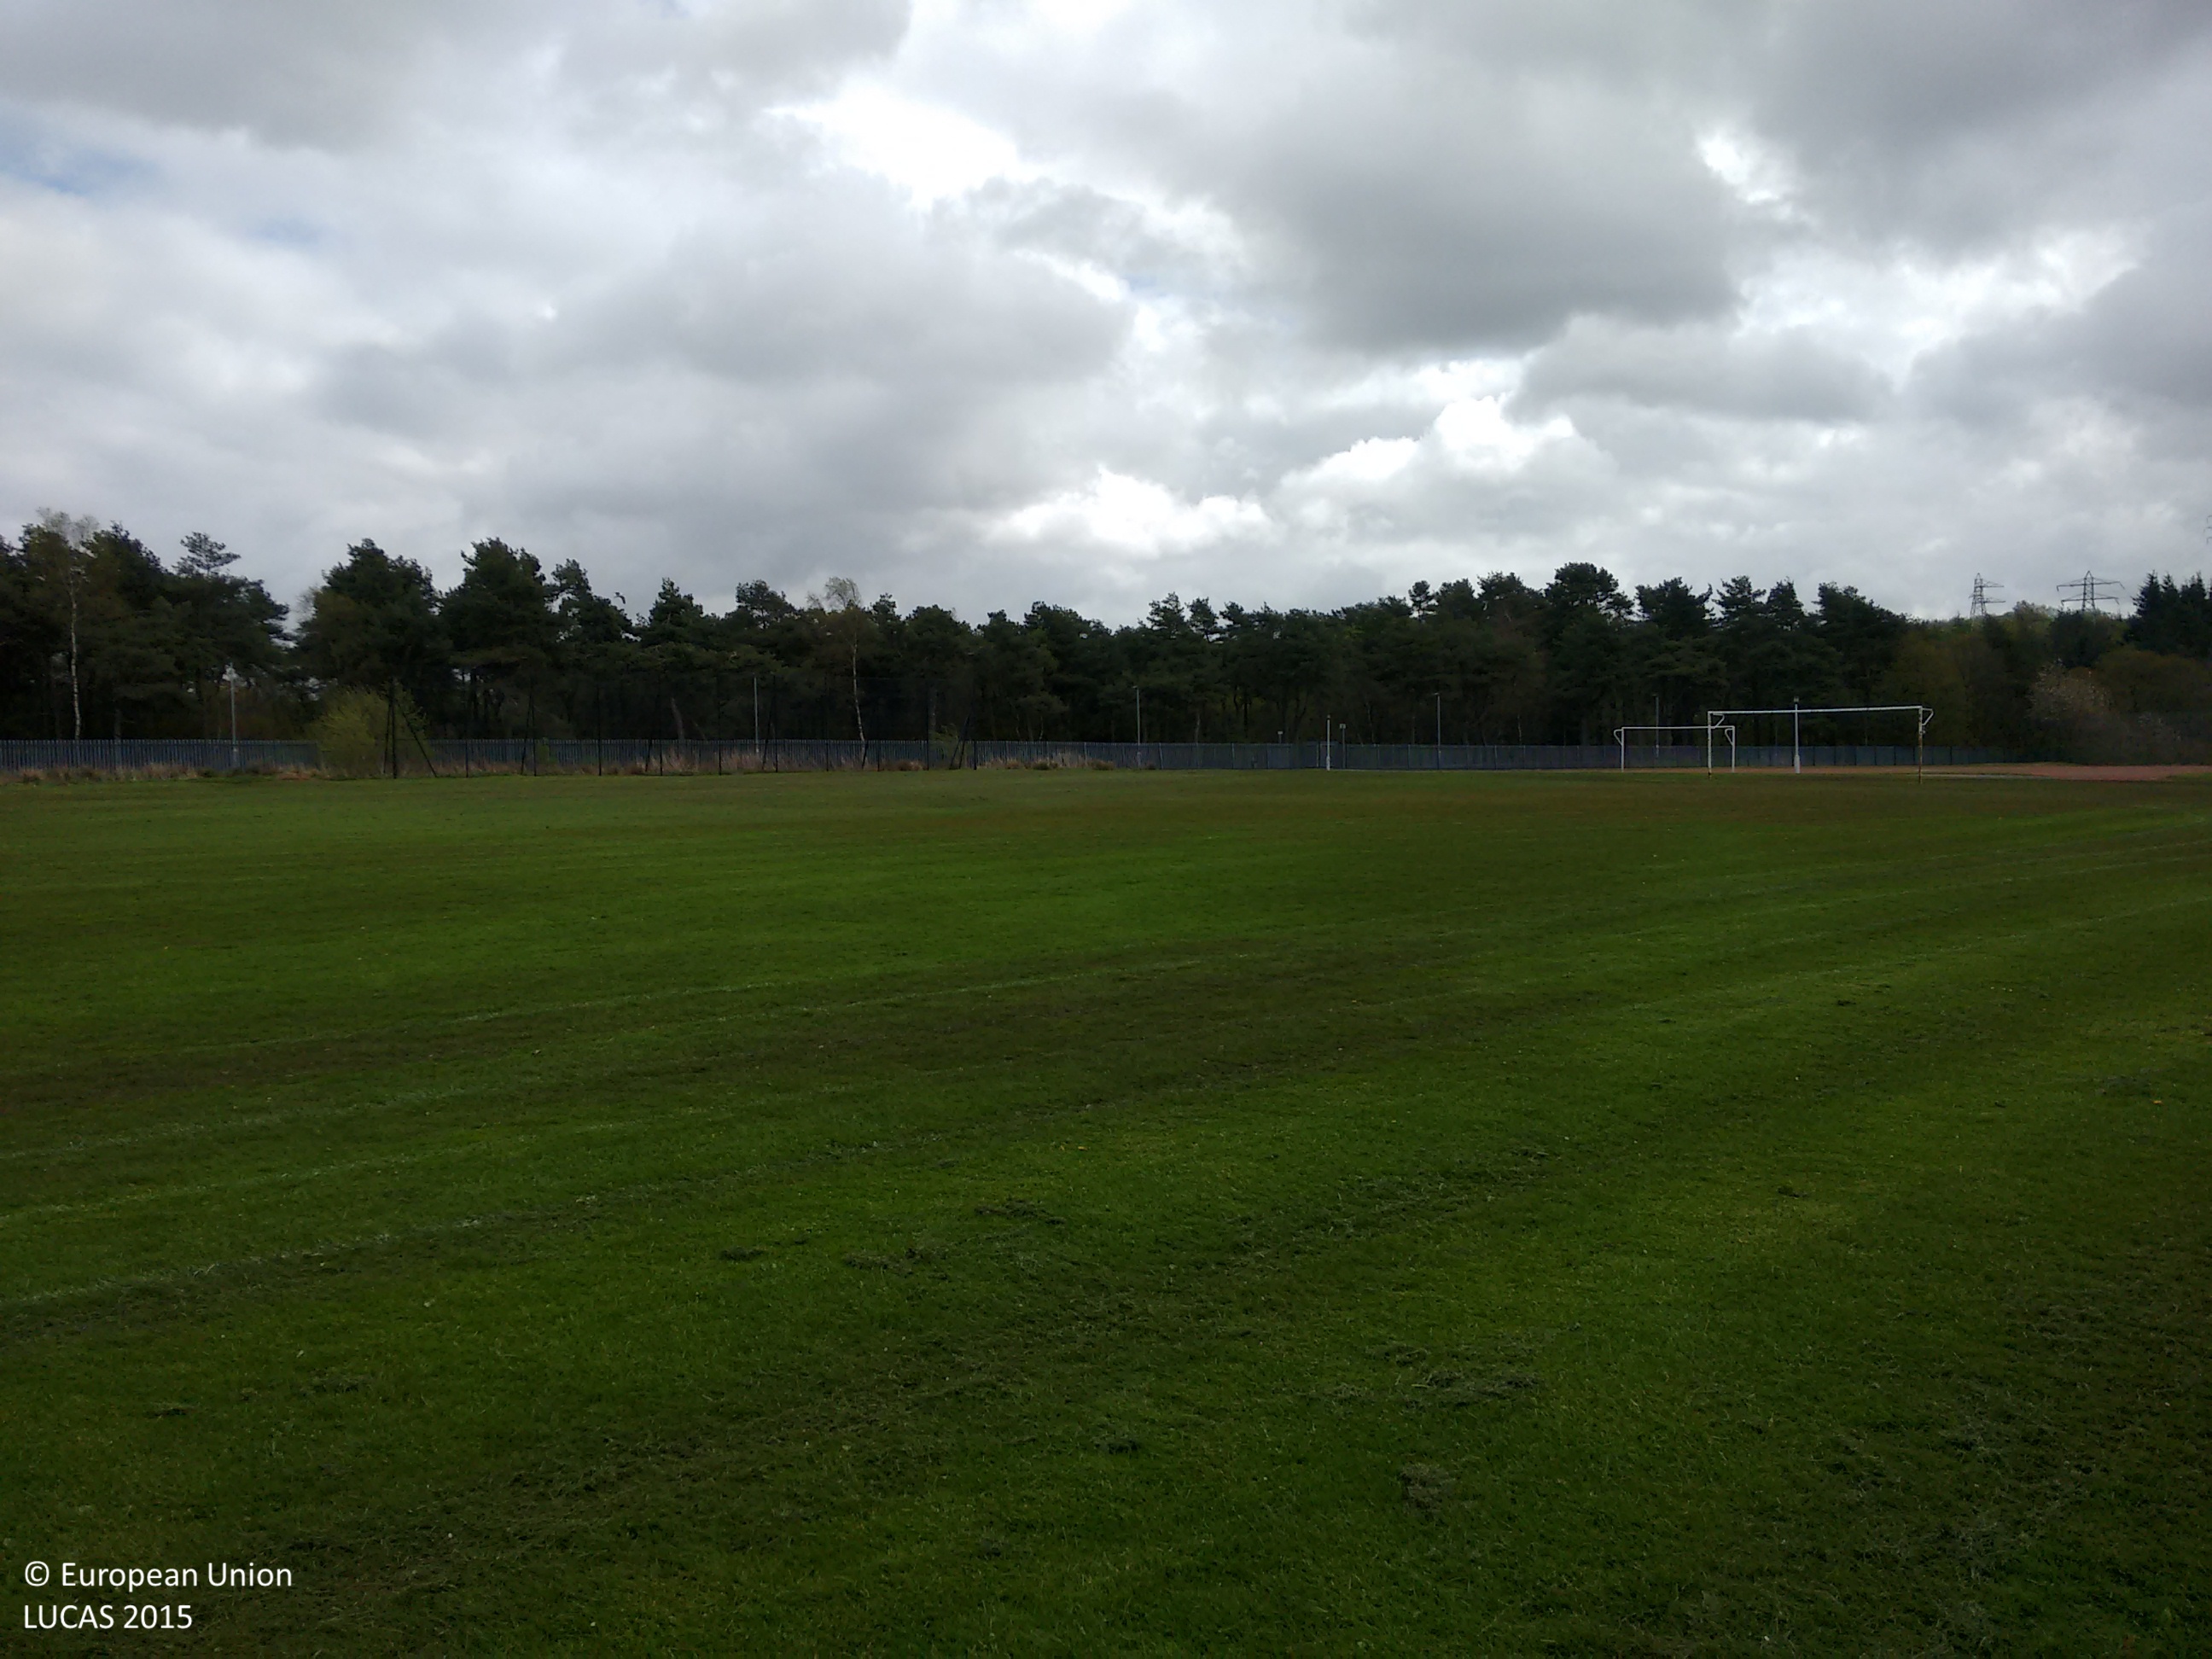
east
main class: Grassland
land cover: Grassland without tree/shrub cover
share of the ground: > 75 %
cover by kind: herbaceous plants 100 %
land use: Sport
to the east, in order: Grassland without tree/shrub cover; Artificial constructions in urban areas; Tracks; Broadleaved woodland; Pine dominated coniferous woodland; Tracks; Broadleaved woodland
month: May
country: GB
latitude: 55.9484
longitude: -3.9705
